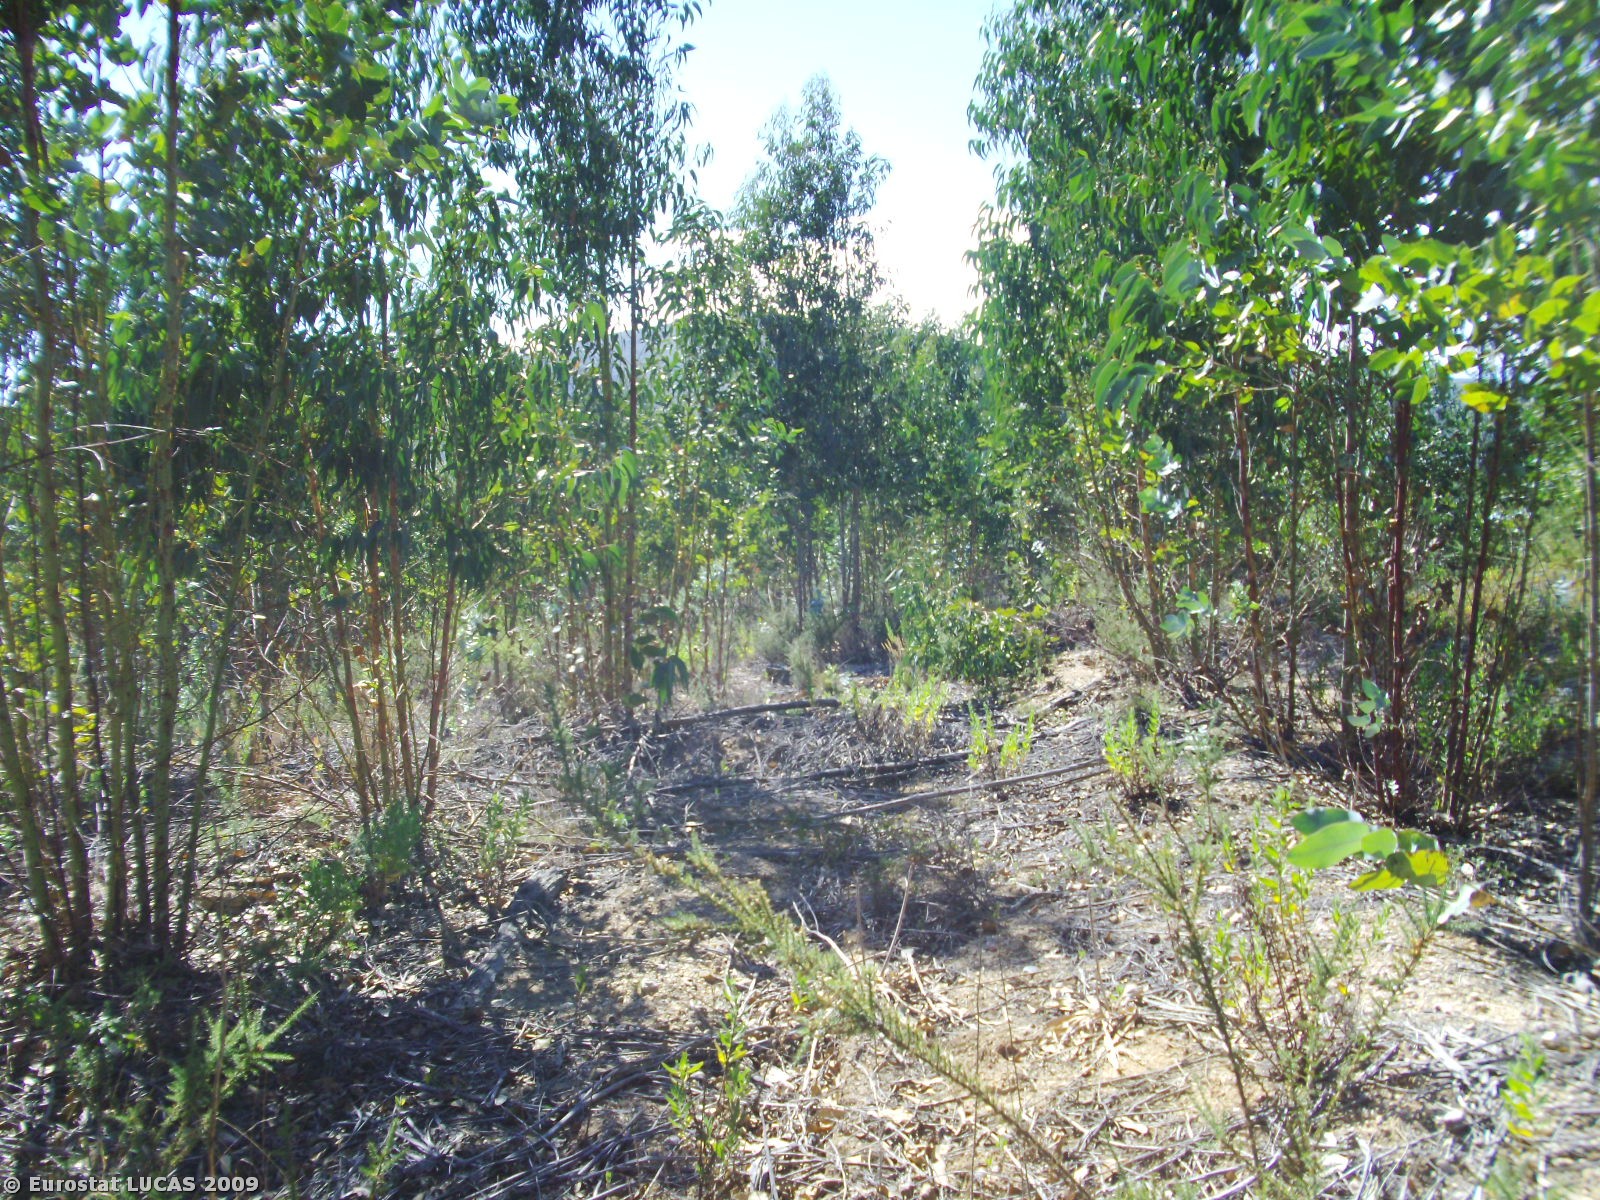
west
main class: Woodland
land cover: Broadleaved woodland
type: plantations and self-sown exotic forest
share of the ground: 50 - 75 %
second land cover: Shrubland with sparse tree cover
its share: 25 - 50 %
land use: Forestry
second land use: Unused
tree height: > 5 m
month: July
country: PT
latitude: 39.1685
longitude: -9.0041
